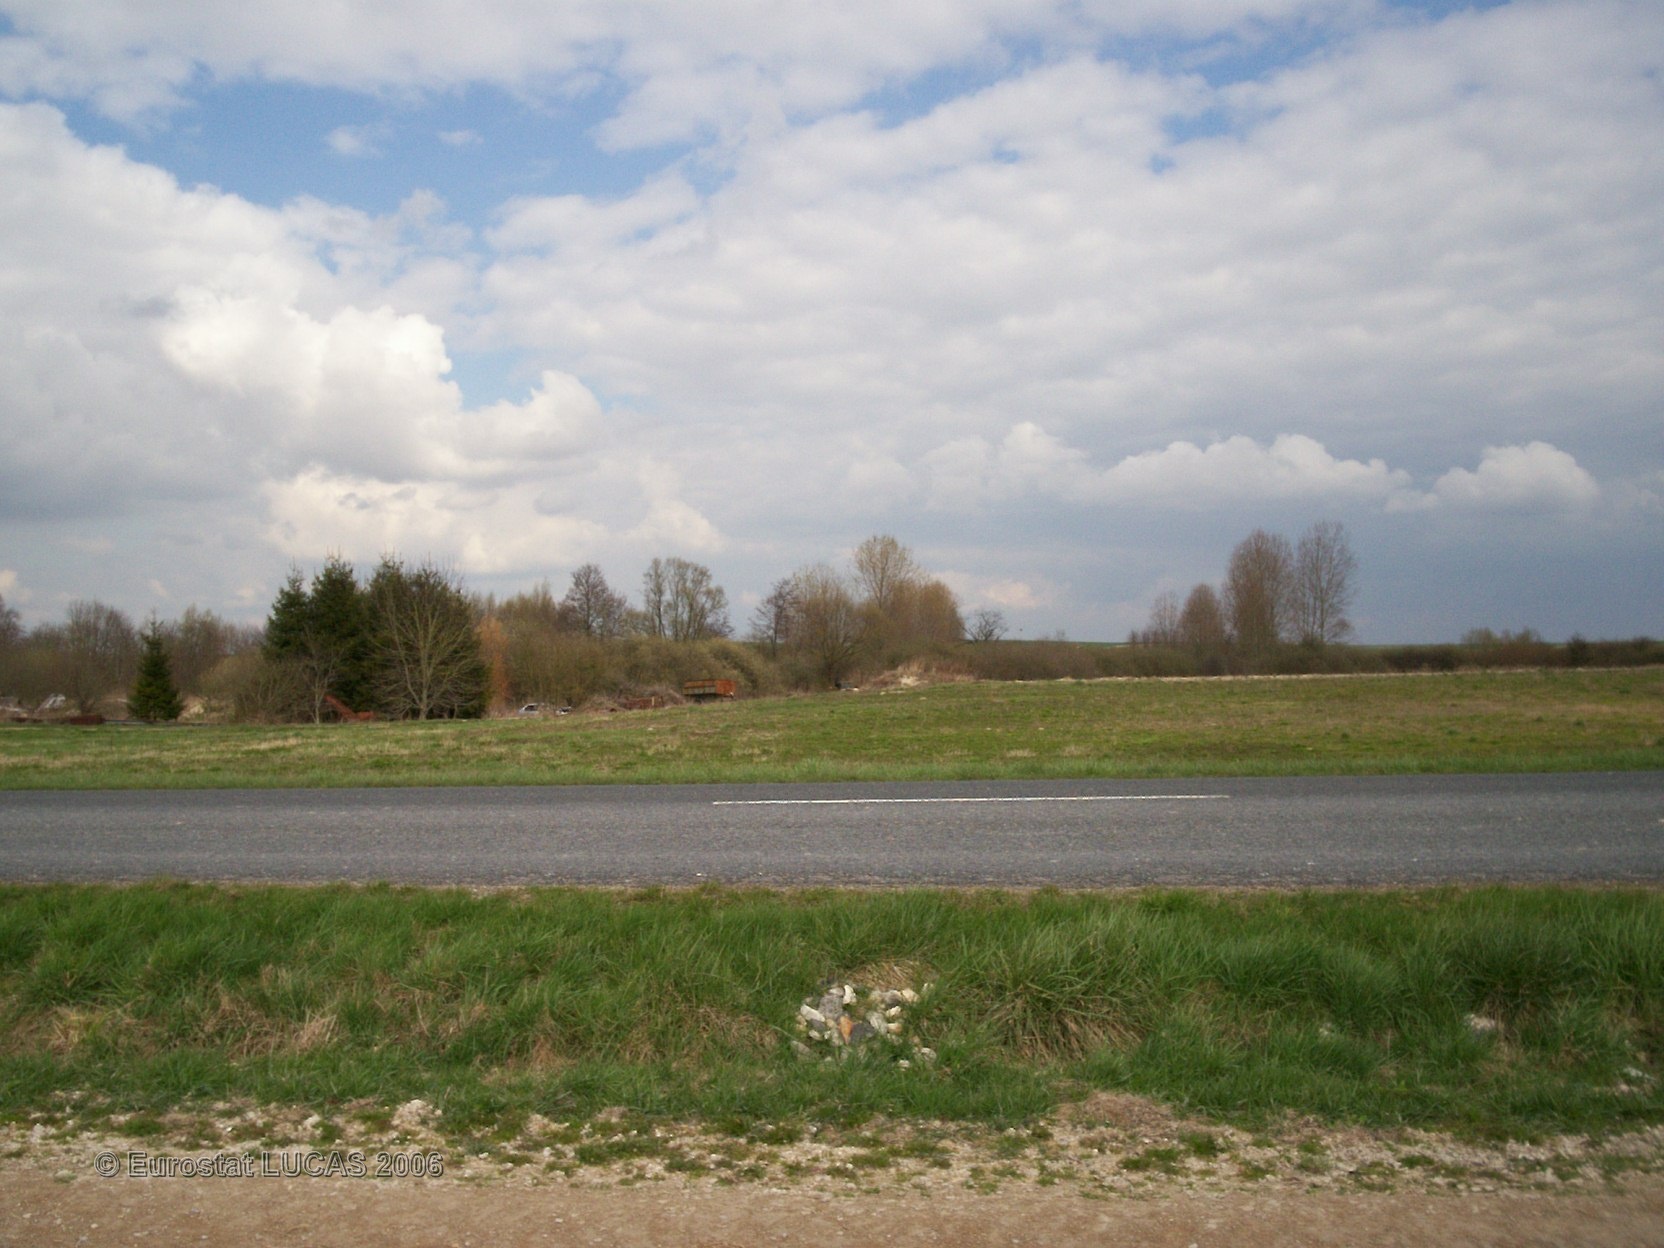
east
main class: Cropland
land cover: Sugar beet
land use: Agriculture (excluding fallow land and kitchen gardens)
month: June
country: FR
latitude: 49.2178
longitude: 4.4085
